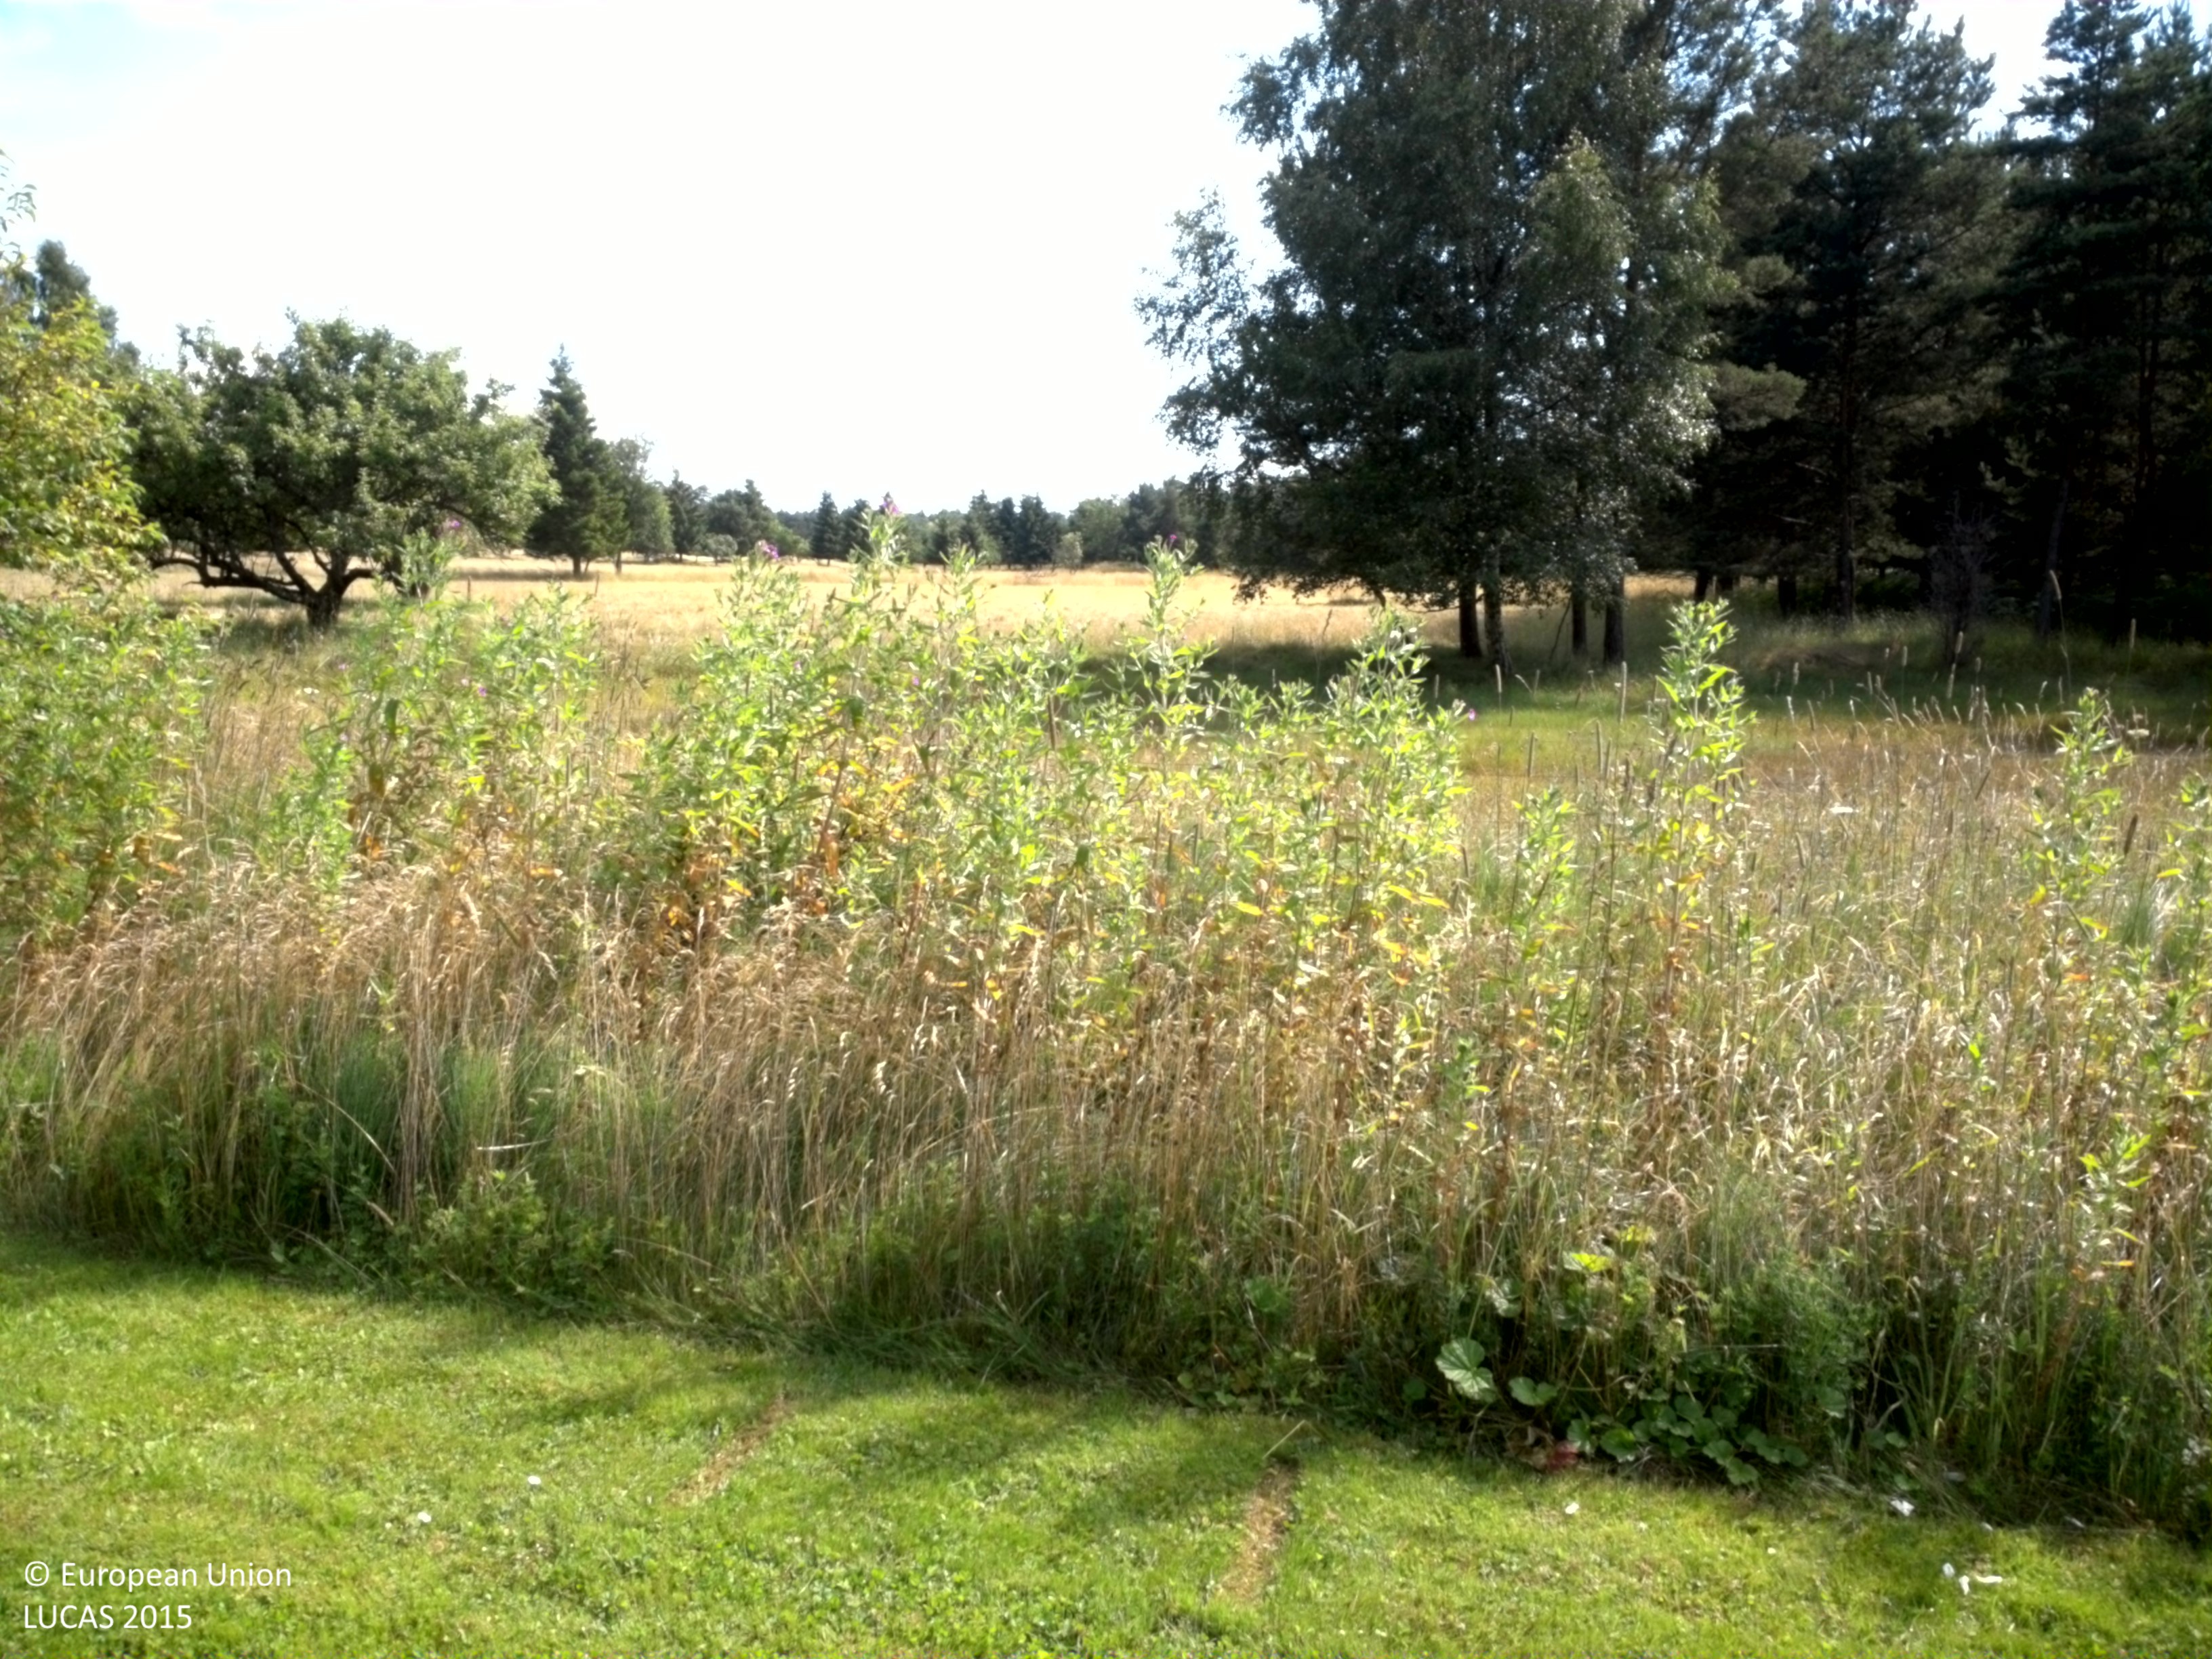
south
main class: Grassland
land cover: Grassland without tree/shrub cover
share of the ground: > 75 %
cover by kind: herbaceous plants 100 %
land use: Residential
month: July
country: SE
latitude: 57.2782
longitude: 18.2514
